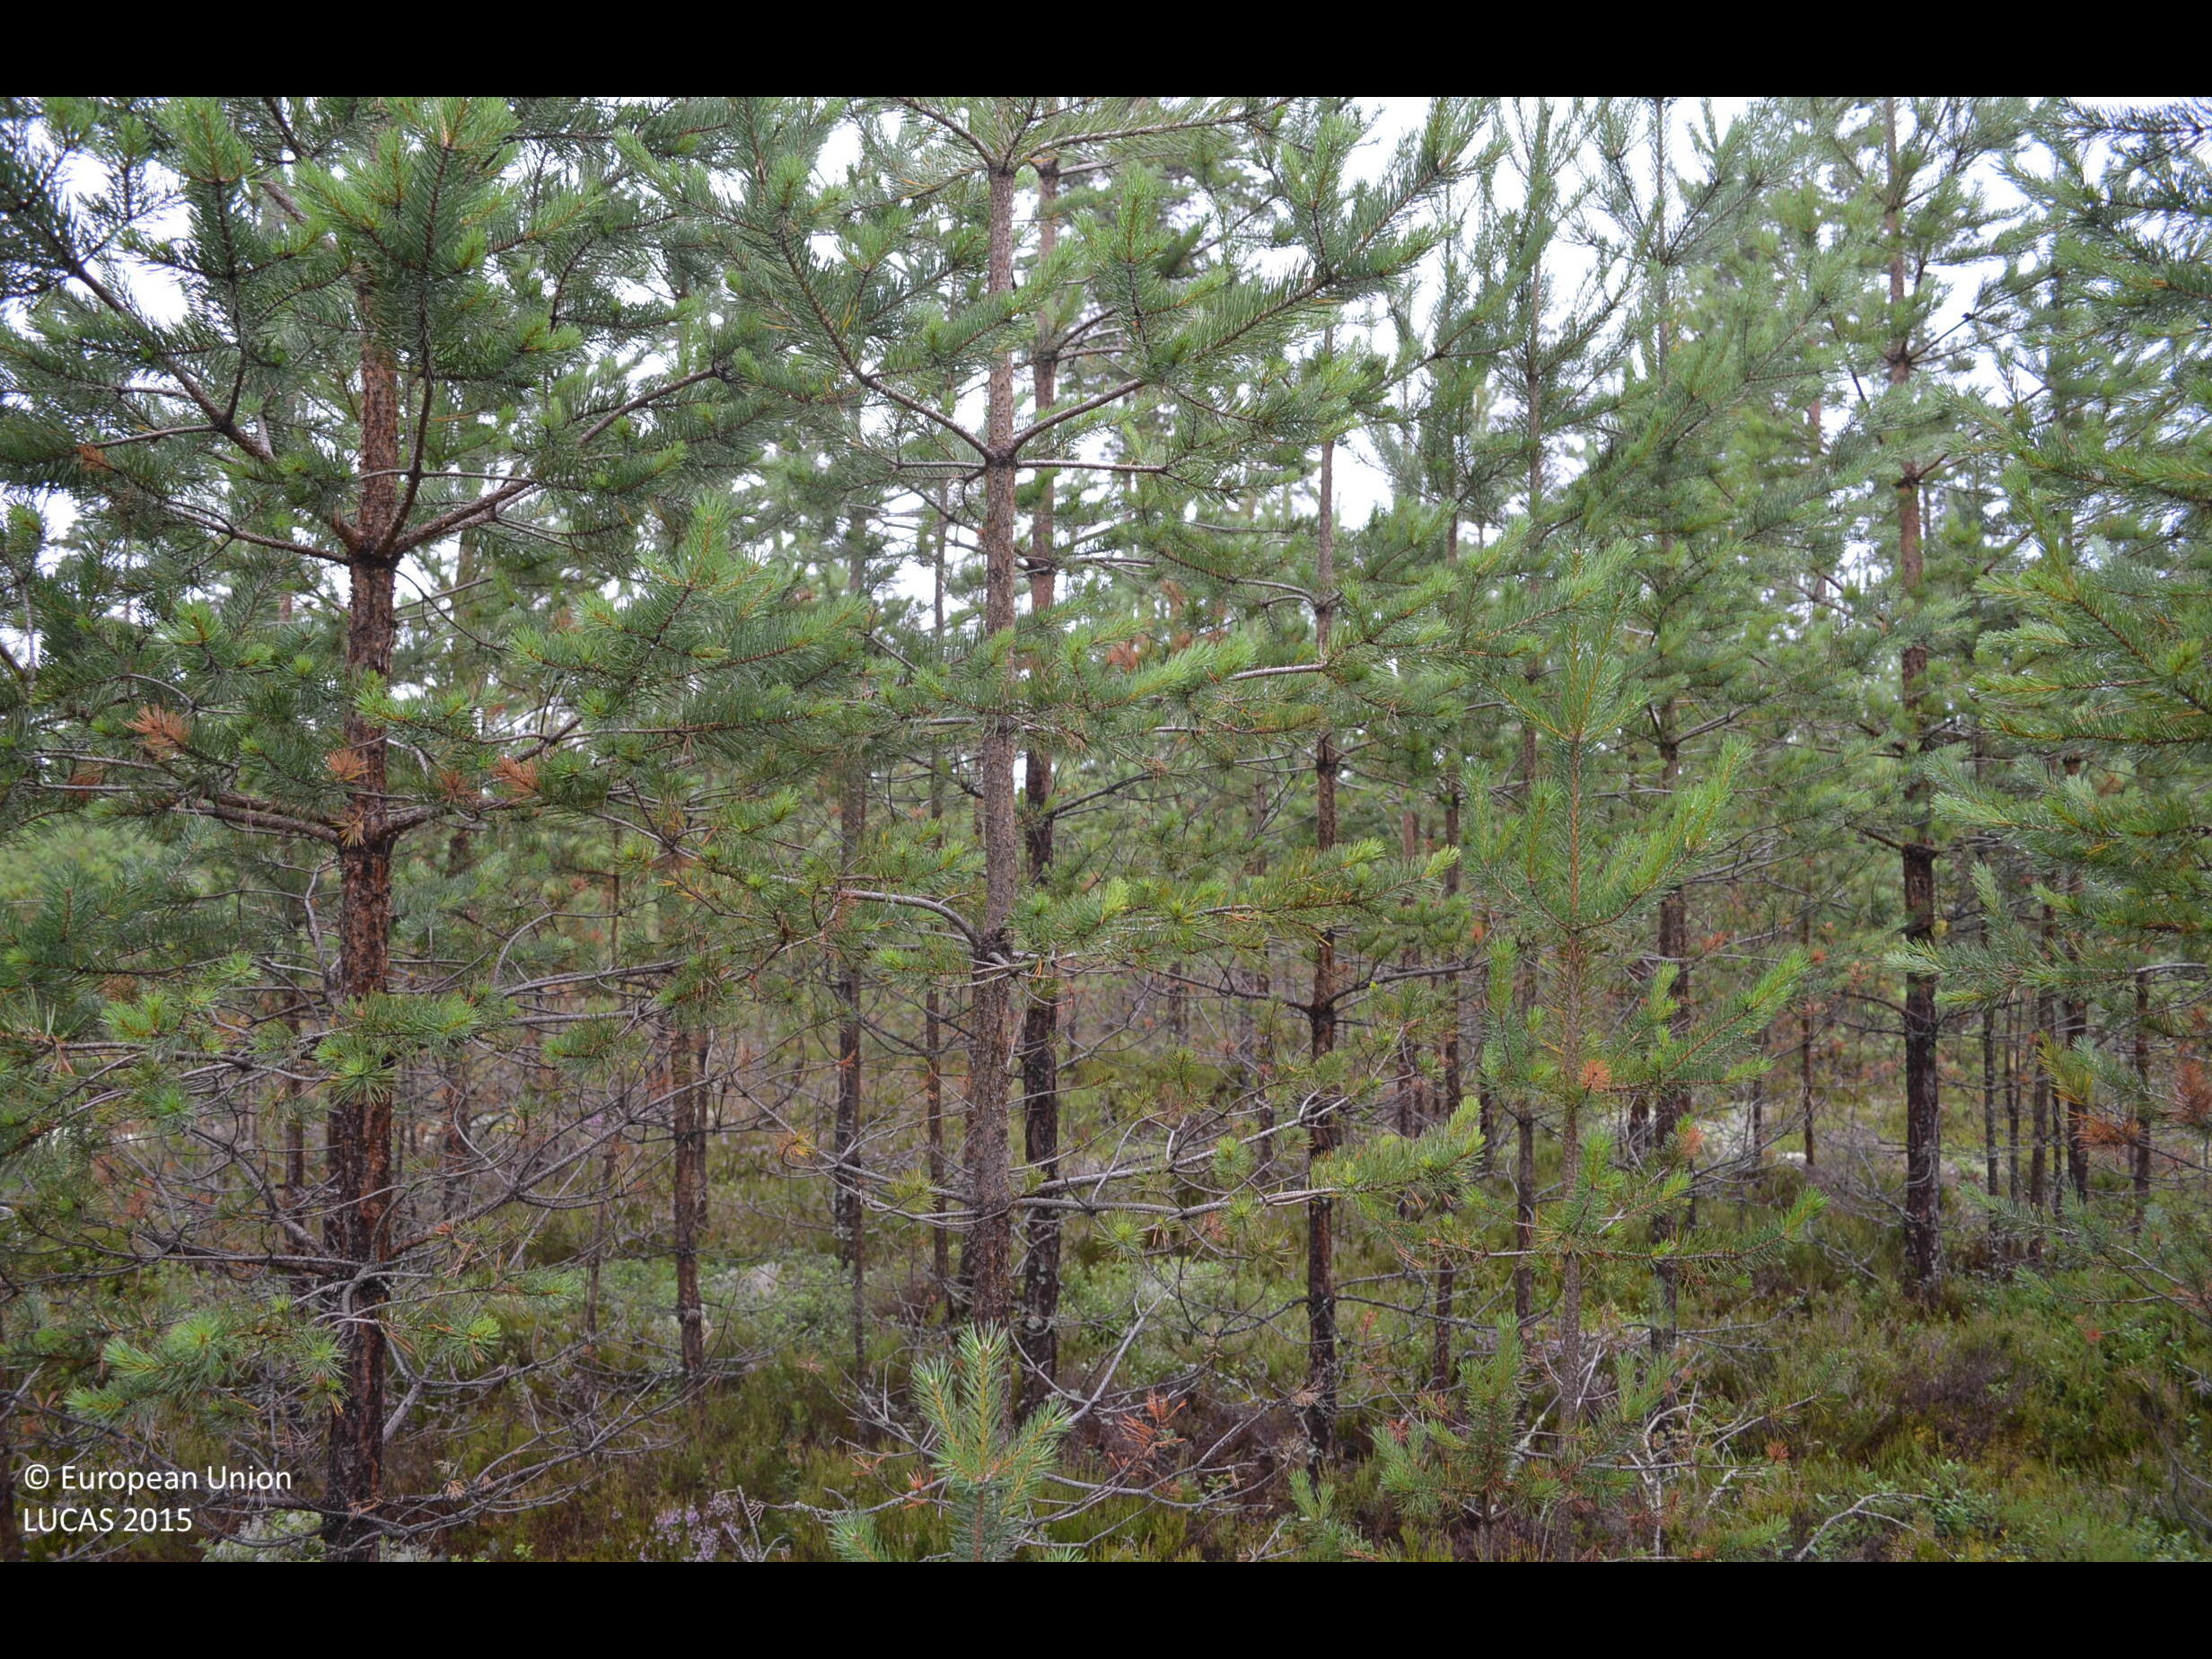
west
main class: Woodland
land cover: Pine dominated coniferous woodland
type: boreal forest
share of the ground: > 75 %
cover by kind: coniferous forest trees 75 %, shrubs 15 %, lichens and mosses 10 %
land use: Forestry
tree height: < 5 m
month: August
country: FI
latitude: 61.8320
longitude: 24.1212
